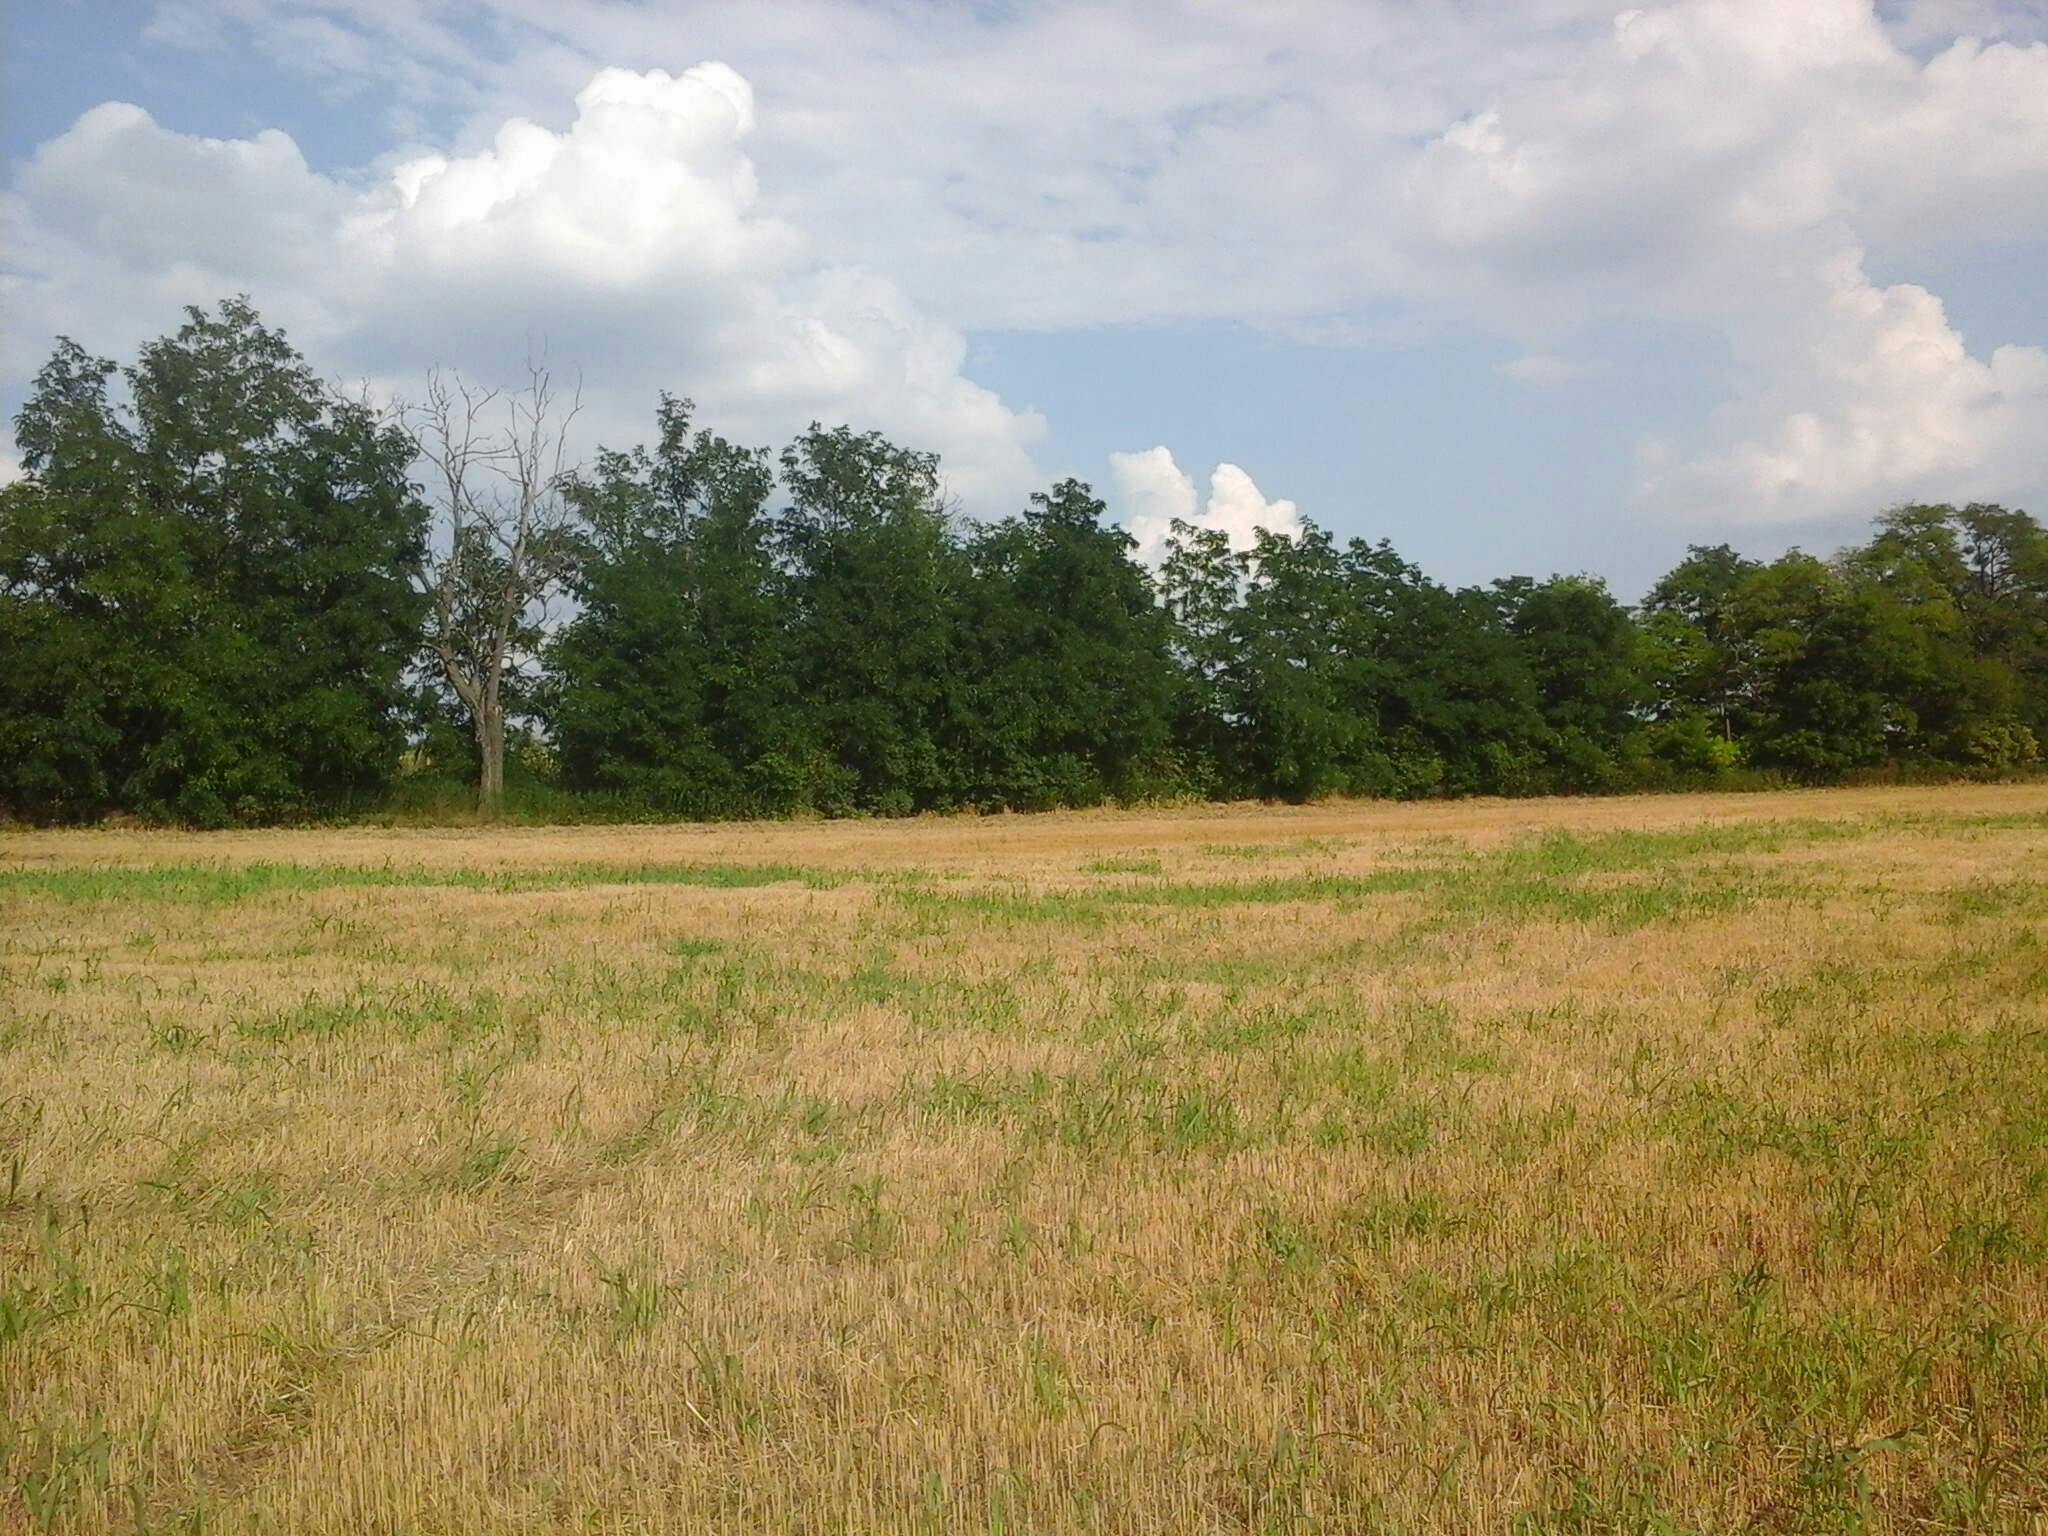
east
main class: Cropland
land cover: Common wheat
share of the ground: > 75 %
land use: Agriculture (excluding fallow land and kitchen gardens)
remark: Harvested field
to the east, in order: Common wheat; Lines of trees; Grass margins; Paved roads, cycling and walking lanes; Grass margins; Lines of trees; Common wheat
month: August
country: HU
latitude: 47.5730
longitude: 18.2144
